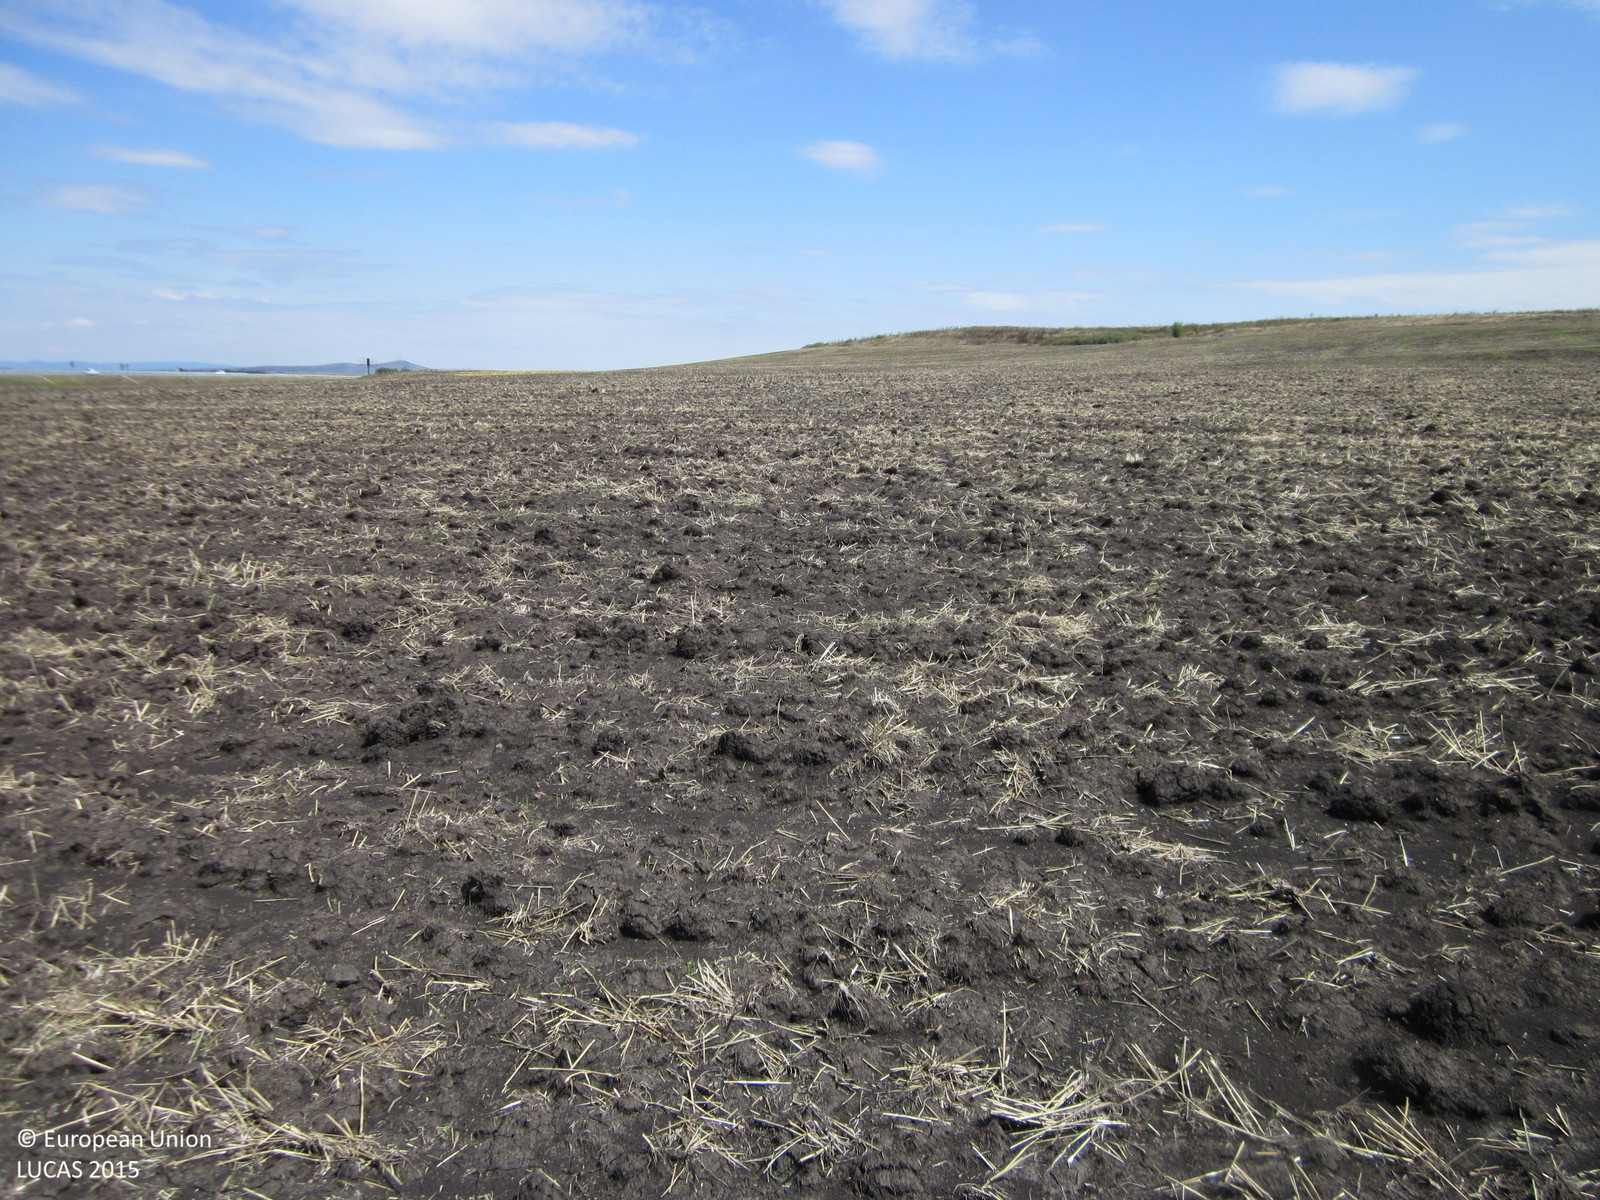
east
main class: Cropland
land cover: Common wheat
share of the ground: 10 - 25 %
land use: Agriculture (excluding fallow land and kitchen gardens)
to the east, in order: Common wheat; Grass margins; Tracks; Shrubland without tree cover
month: August
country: BG
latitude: 42.5695
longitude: 26.8771
